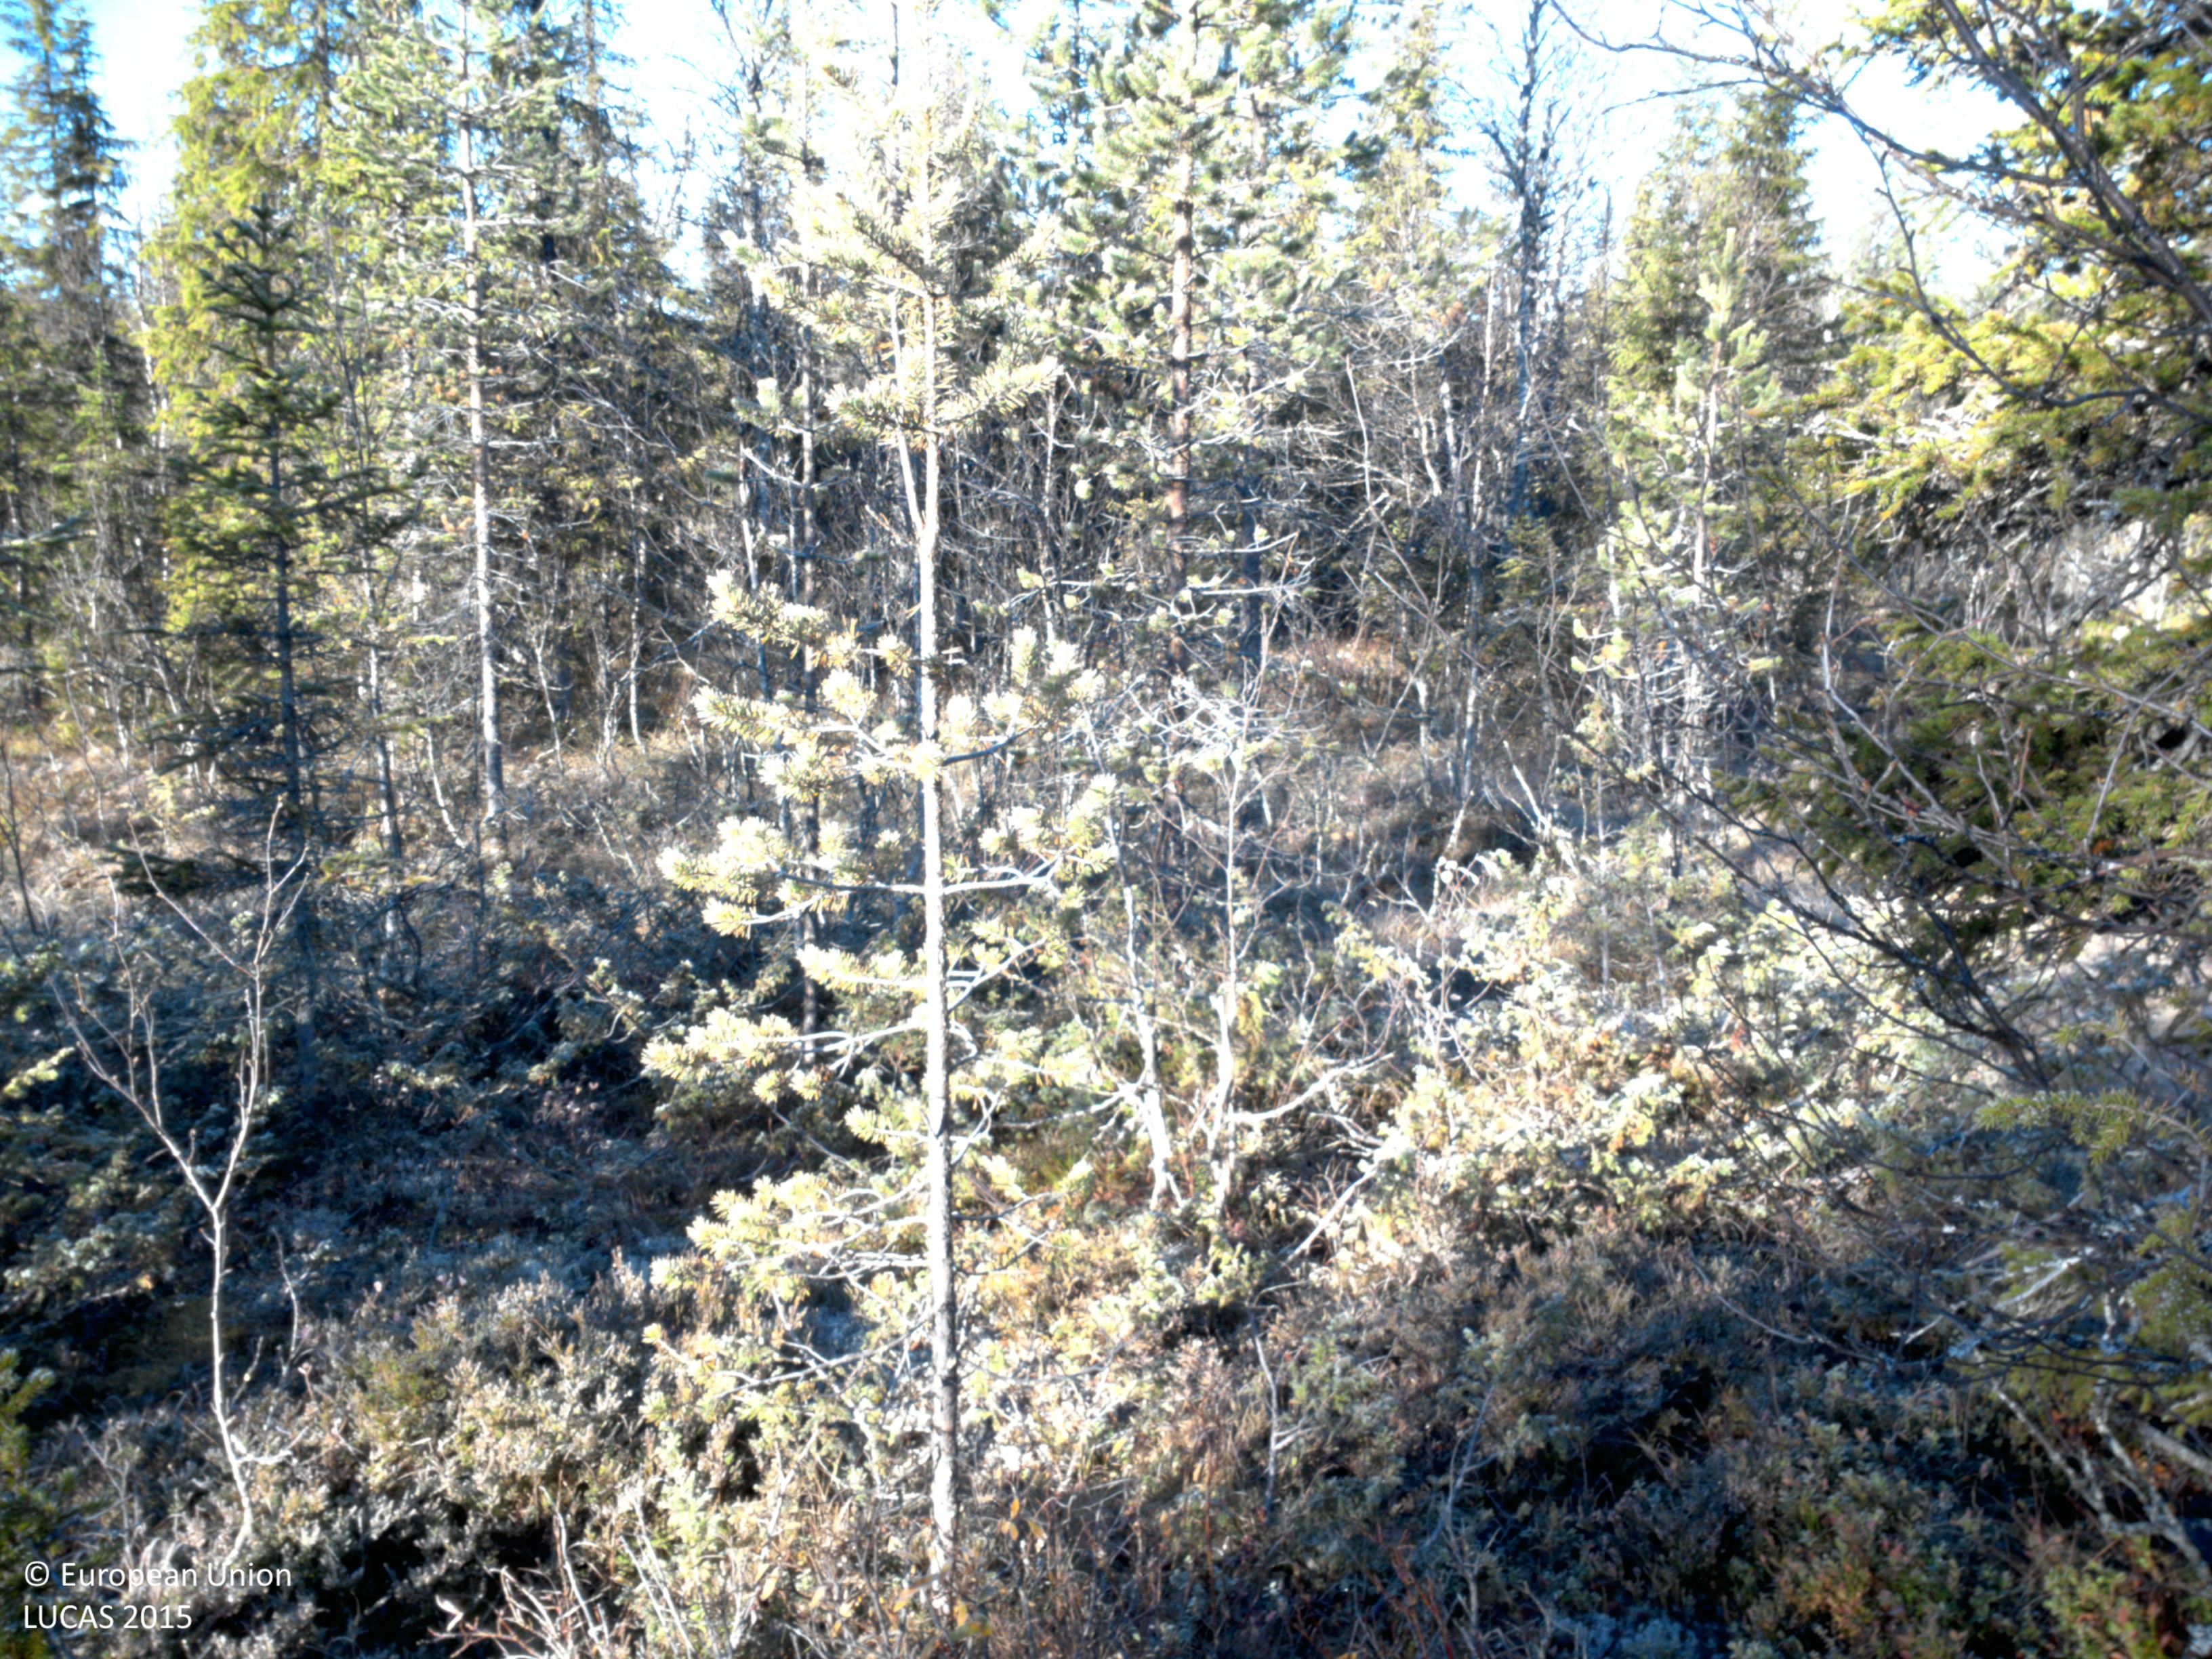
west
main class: Woodland
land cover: Spruce dominated mixed woodland
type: mire and swamp forests
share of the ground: 25 - 50 %
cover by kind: coniferous forest trees 30 %, shrubs 25 %, broadleaved forest trees 20 %, lichens and mosses 15 %, herbaceous plants 10 %
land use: Forestry
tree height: > 5 m
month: October
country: SE
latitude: 64.7530
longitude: 17.7612
